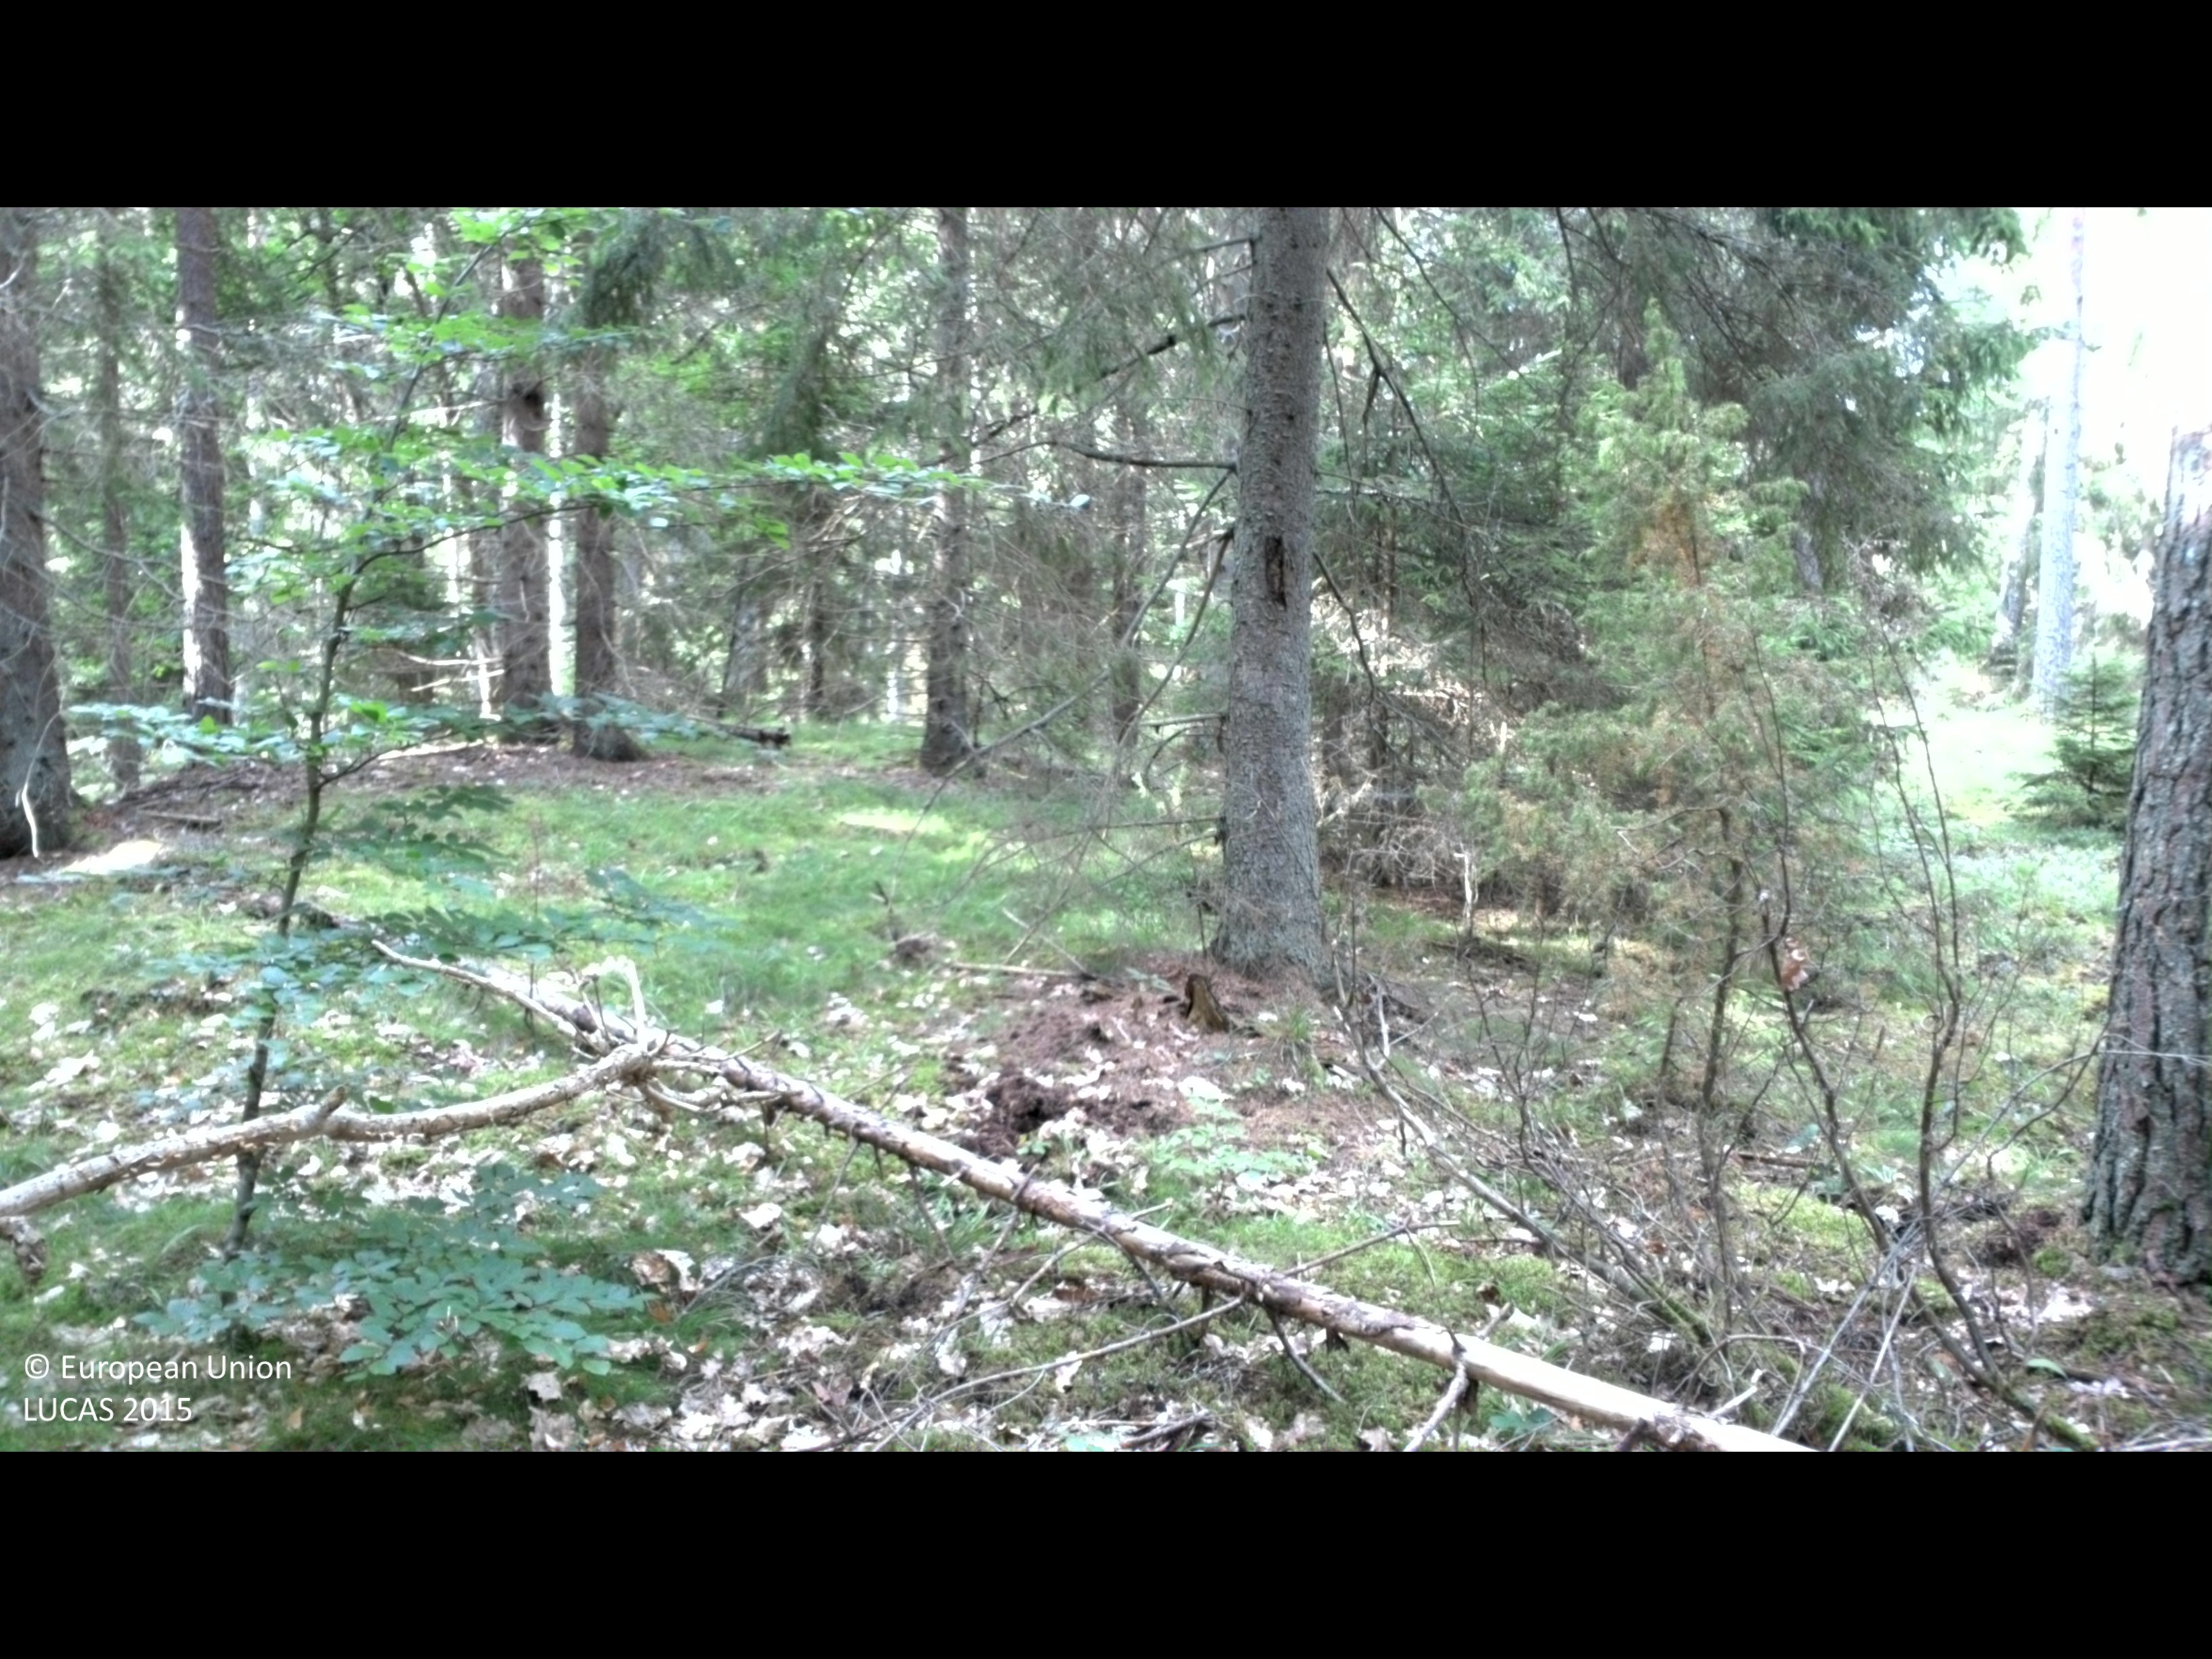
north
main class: Woodland
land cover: Spruce dominated coniferous woodland
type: boreal forest
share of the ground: > 75 %
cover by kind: coniferous forest trees 75 %, lichens and mosses 20 %, herbaceous plants 5 %
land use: Forestry
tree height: > 5 m
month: July
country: SE
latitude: 56.4397
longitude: 14.8152
